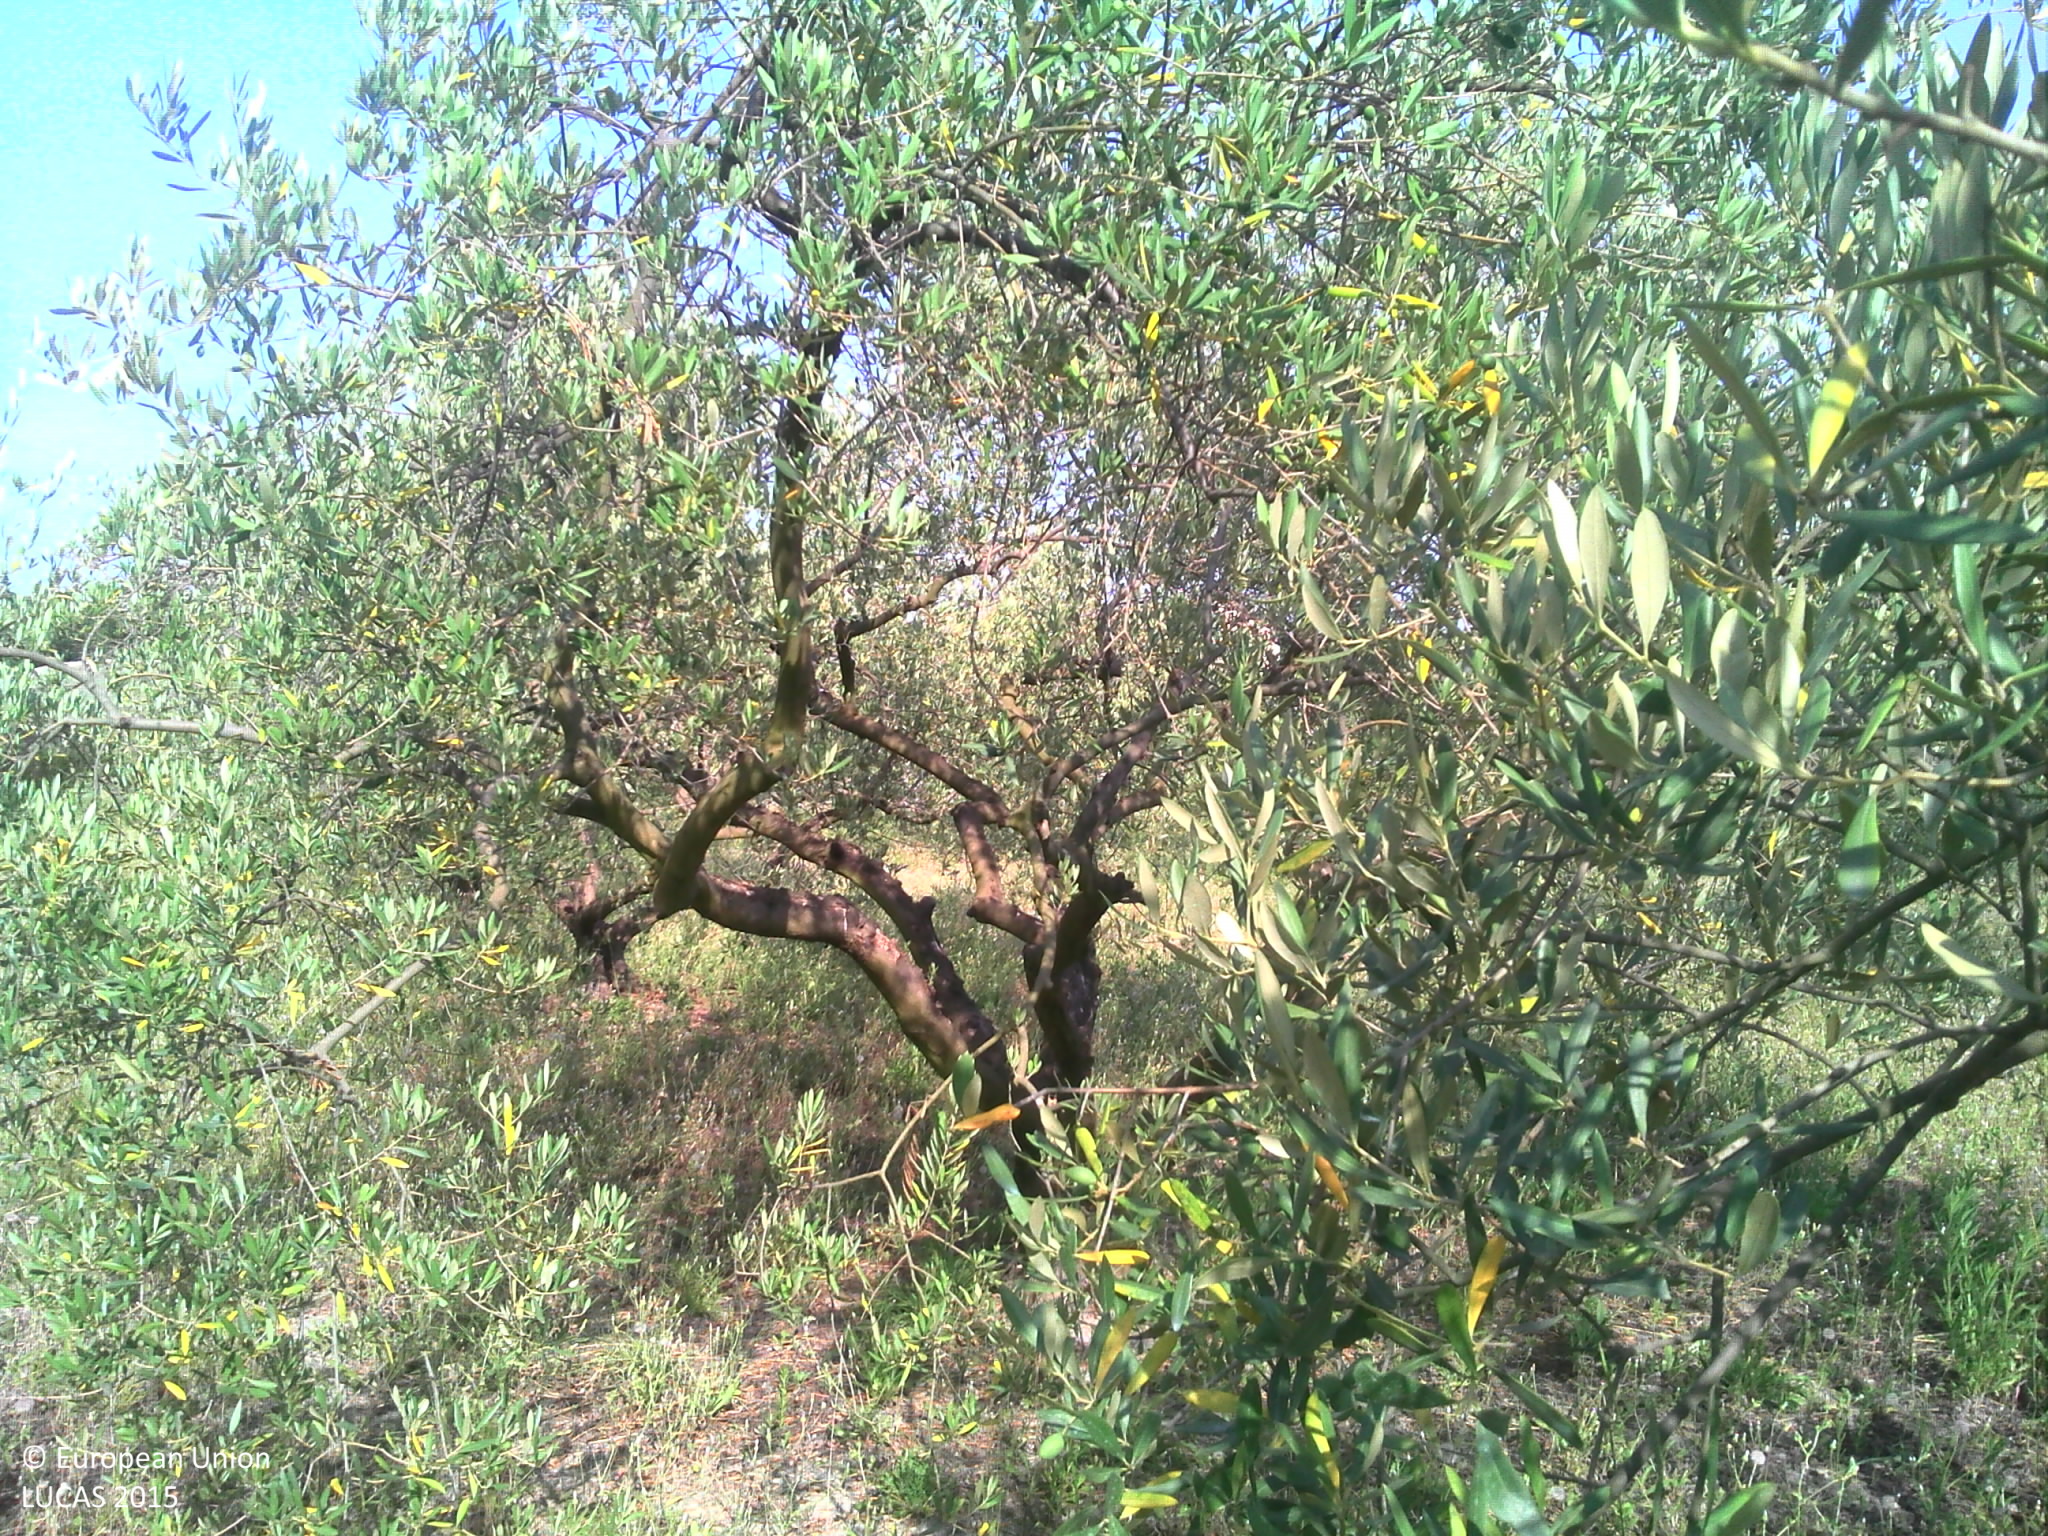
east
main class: Cropland
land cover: Olive groves
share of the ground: 50 - 75 %
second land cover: Grassland without tree/shrub cover
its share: 50 - 75 %
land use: Agriculture (excluding fallow land and kitchen gardens)
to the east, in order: Olive groves; Grassland without tree/shrub cover; Ditches and canals; Grass margins; Other bare soil; Artificial constructions in urban areas; Other fruit trees and berries
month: July
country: FR
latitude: 43.9113
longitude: 4.7662
